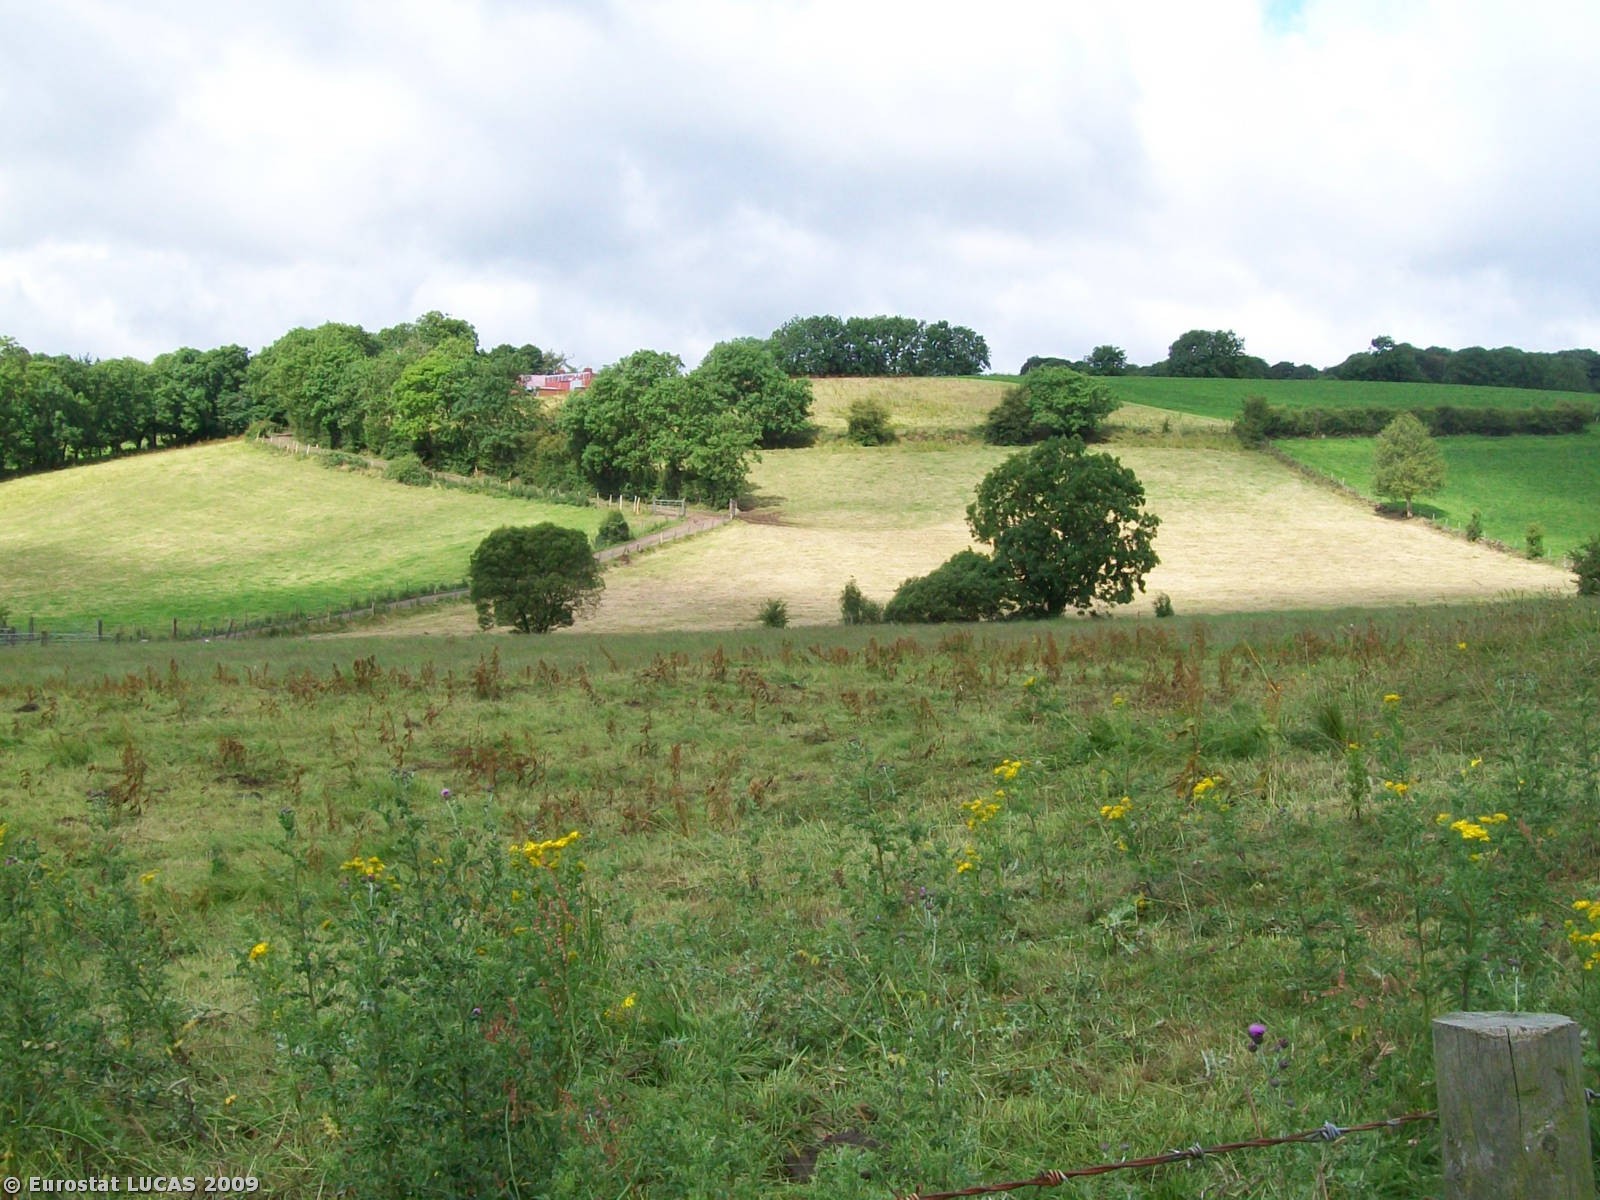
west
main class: Grassland
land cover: Grassland with sparse tree/shrub cover
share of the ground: > 75 %
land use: Agriculture (excluding fallow land and kitchen gardens)
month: July
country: GB
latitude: 54.9579
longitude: -6.2474
